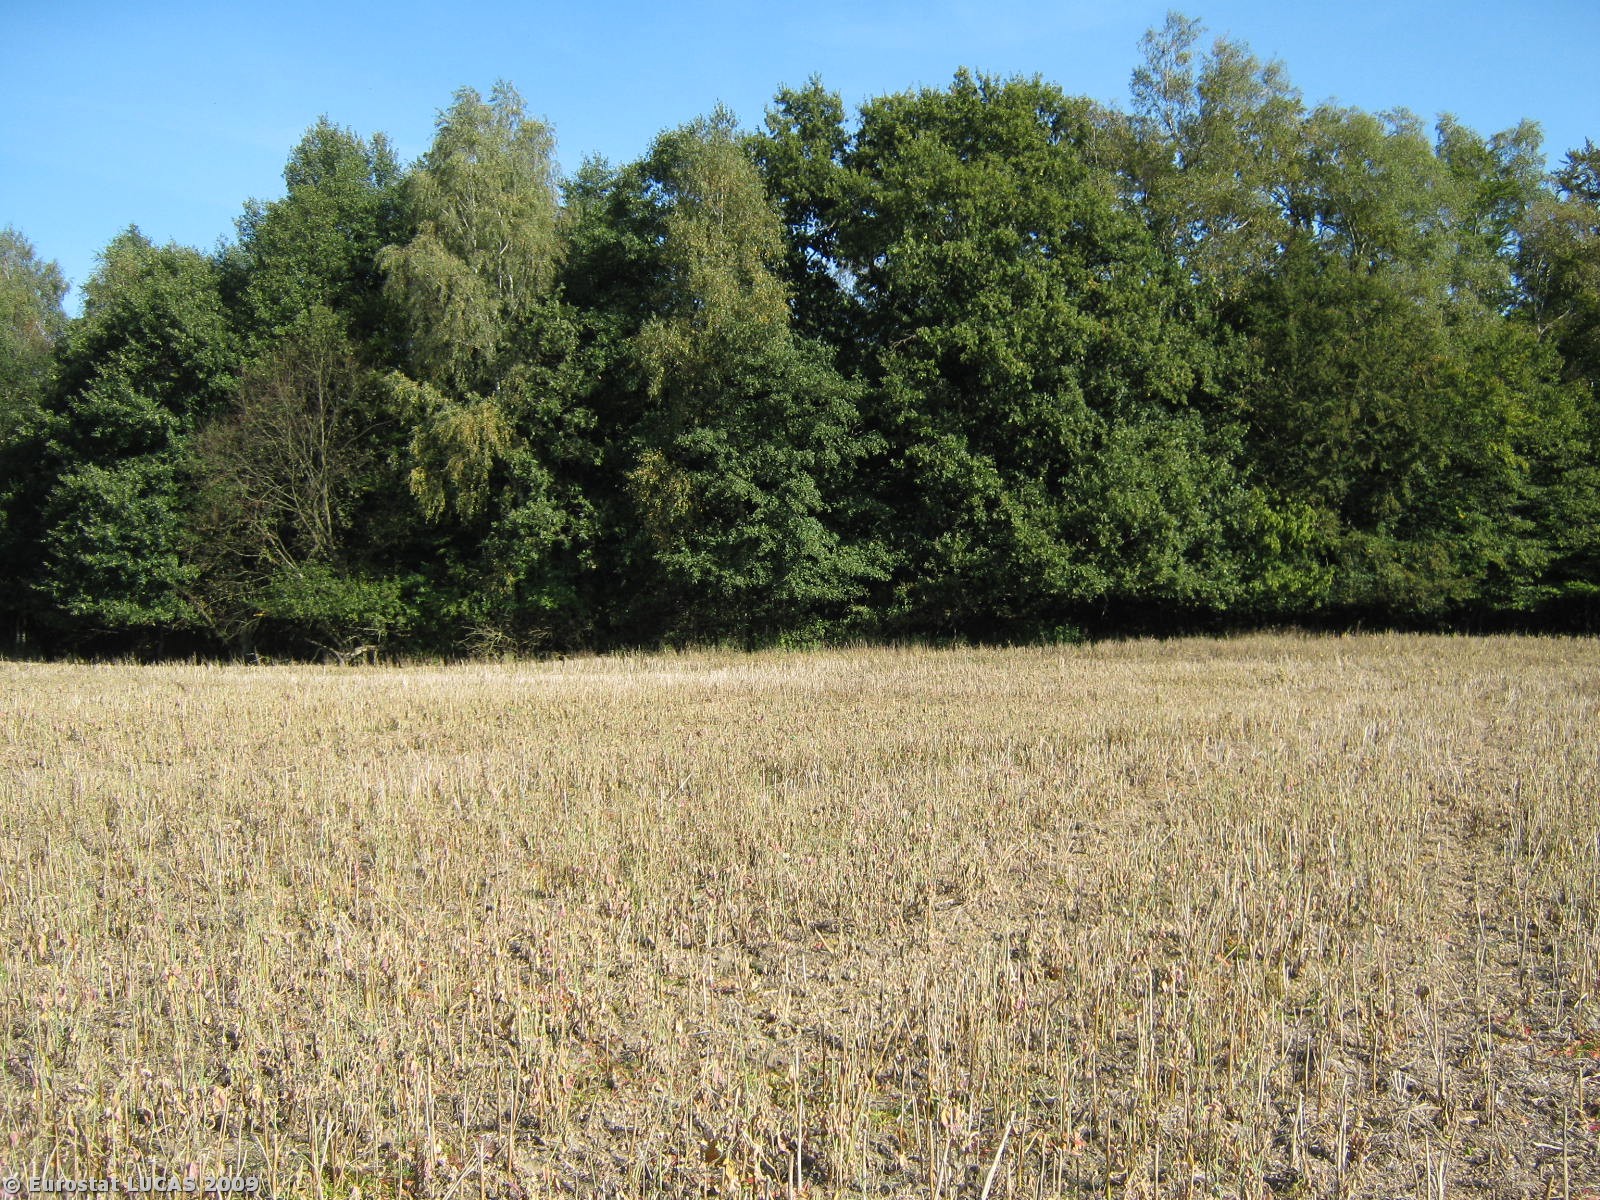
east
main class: Cropland
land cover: Rape and turnip rape
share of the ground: < 10 %
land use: Agriculture (excluding fallow land and kitchen gardens)
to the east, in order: Rape and turnip rape; Broadleaved woodland; Inland running water; Broadleaved woodland
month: September
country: PL
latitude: 53.8650
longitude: 16.3775
